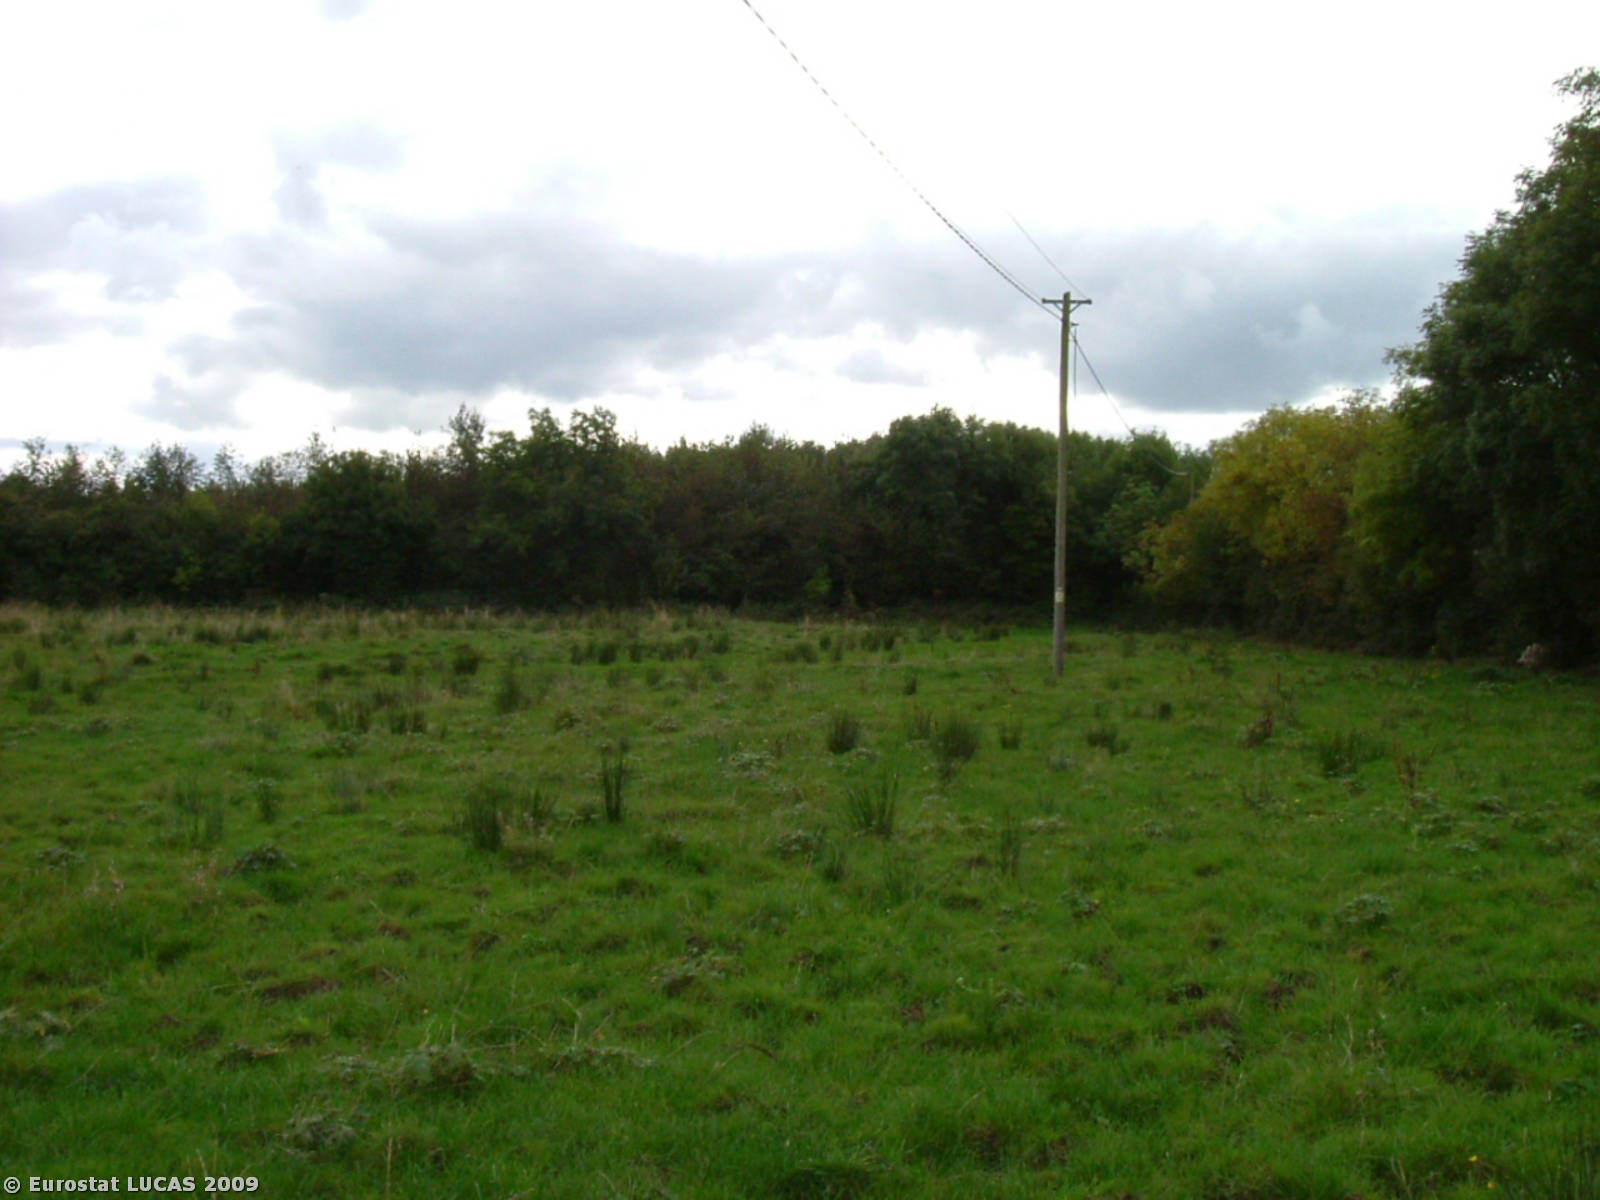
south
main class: Grassland
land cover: Grassland without tree/shrub cover
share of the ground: > 75 %
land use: Agriculture (excluding fallow land and kitchen gardens)
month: October
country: IE
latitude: 52.5380
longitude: -8.2149
